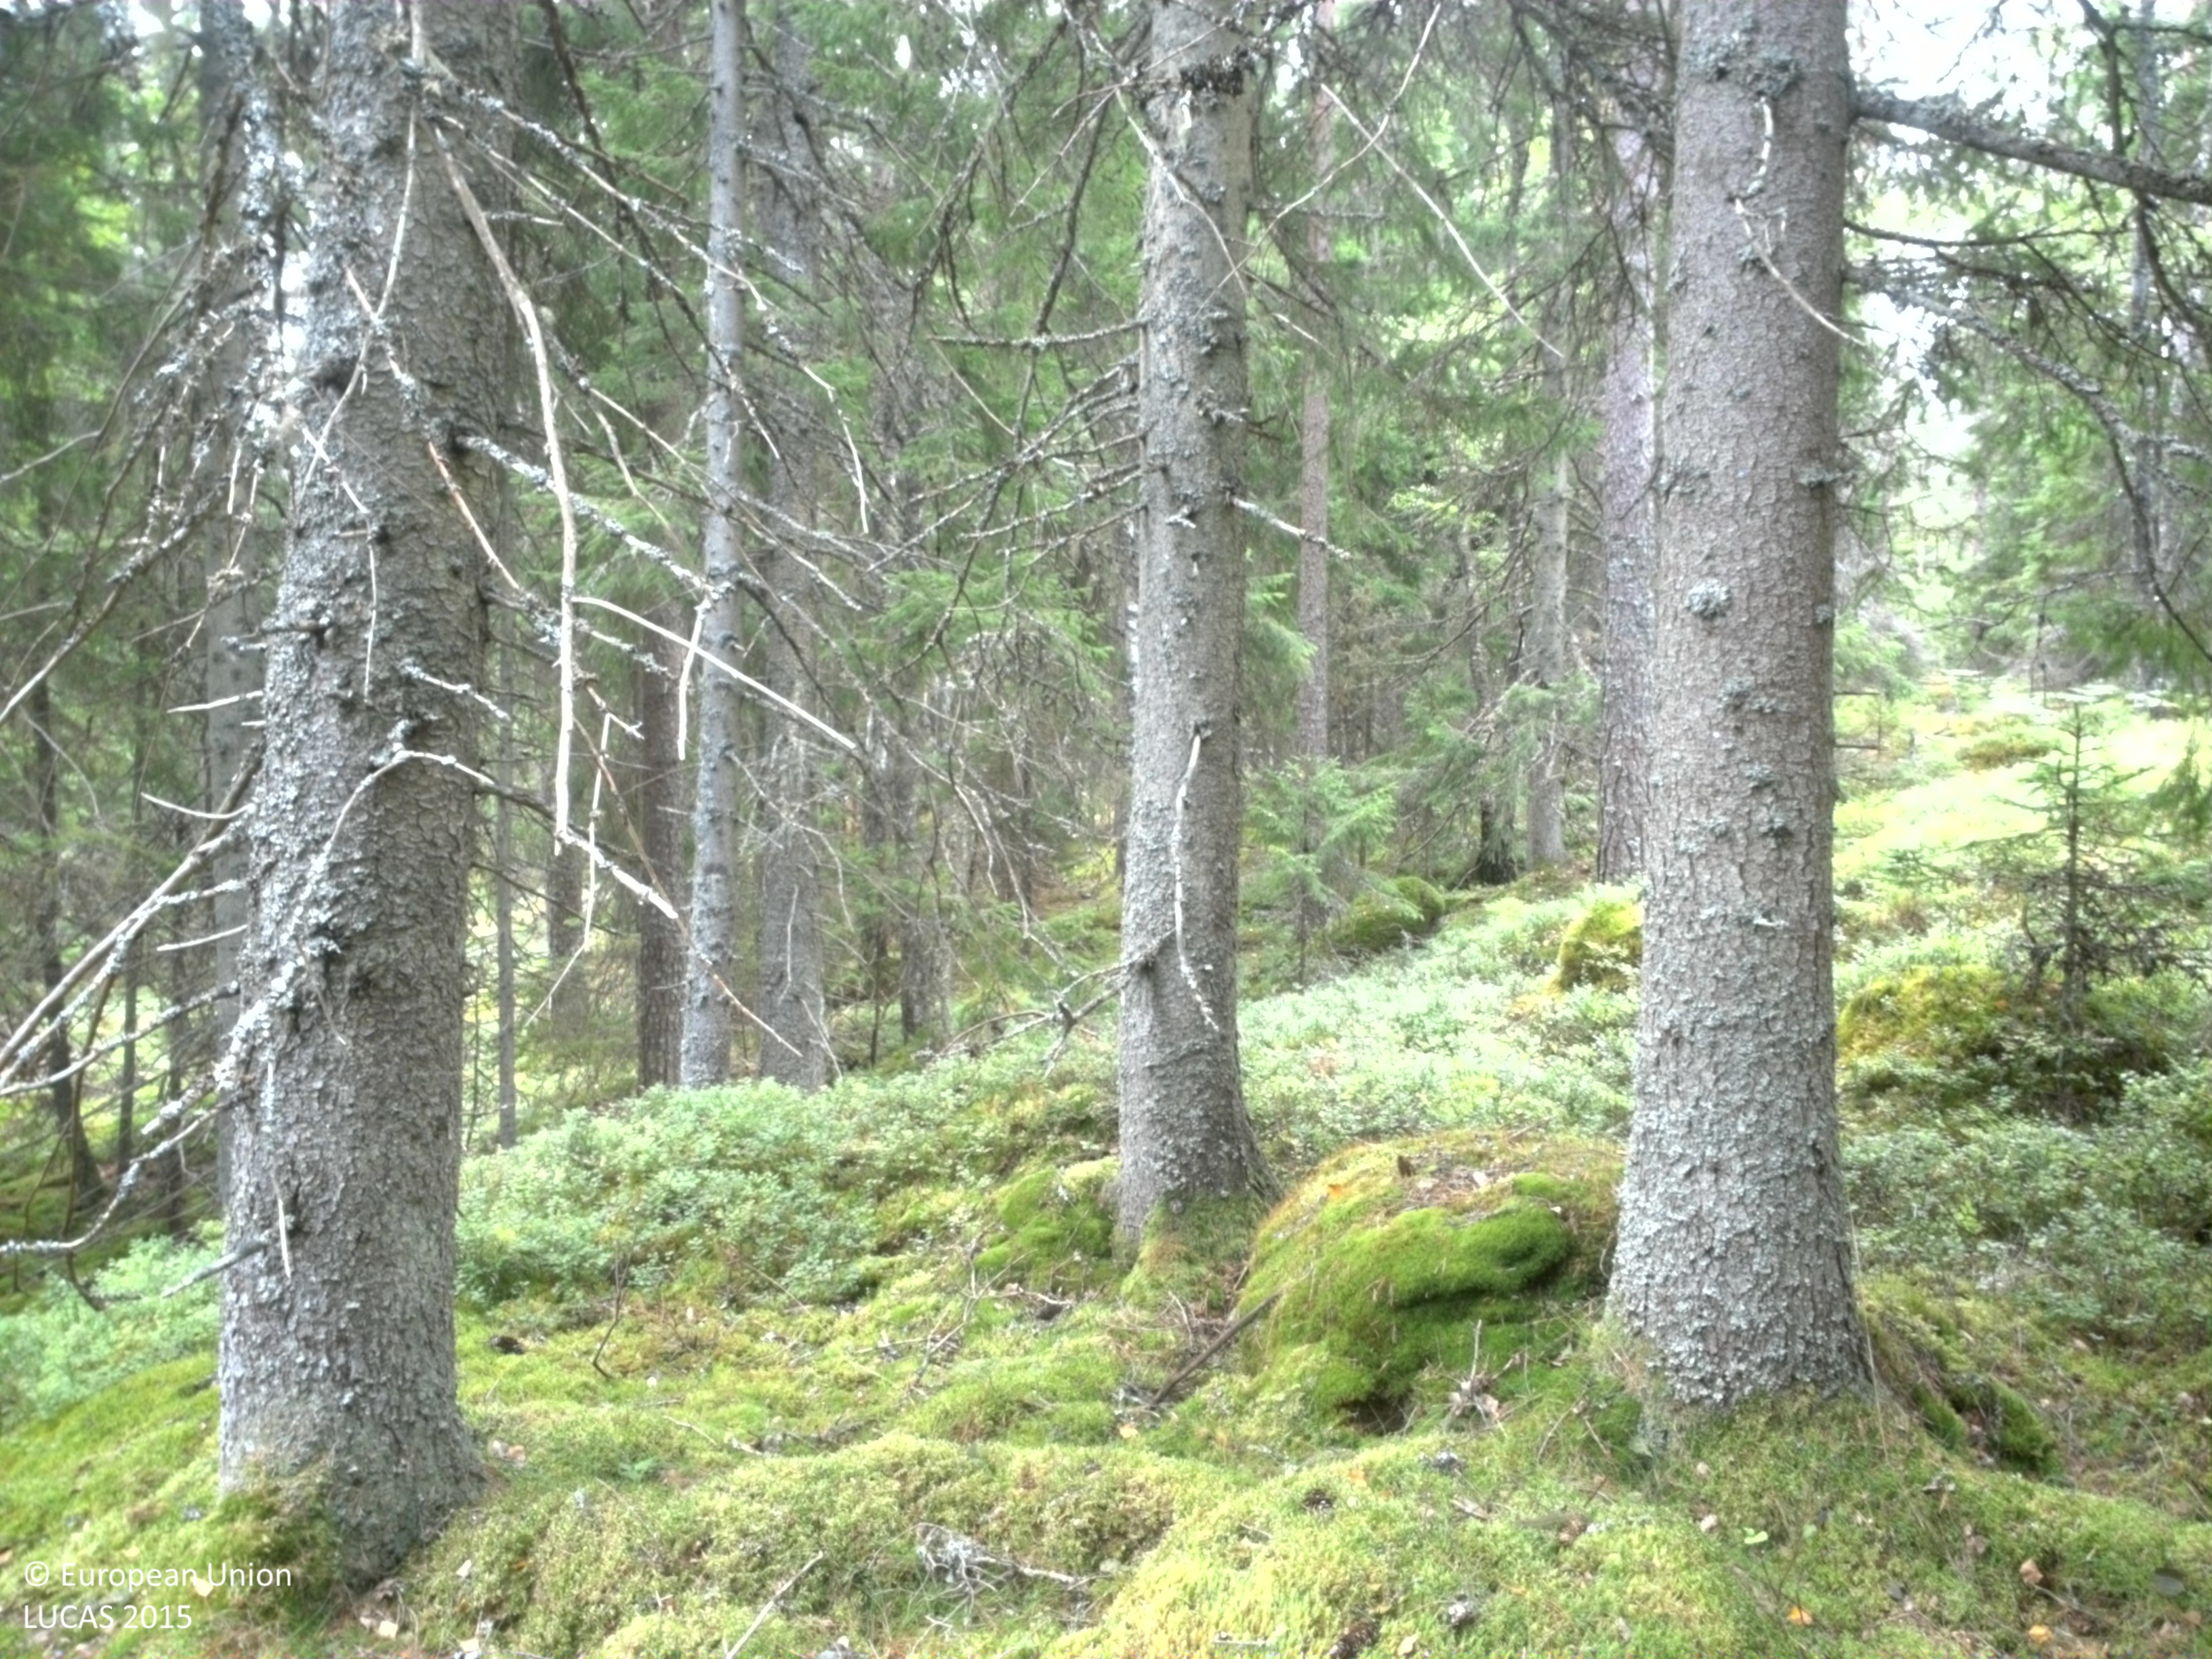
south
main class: Woodland
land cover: Spruce dominated coniferous woodland
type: boreal forest
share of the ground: 50 - 75 %
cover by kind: coniferous forest trees 50 %, lichens and mosses 35 %, shrubs 10 %, broadleaved forest trees 5 %
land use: Forestry
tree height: > 5 m
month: August
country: SE
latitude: 57.8193
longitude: 13.9510
